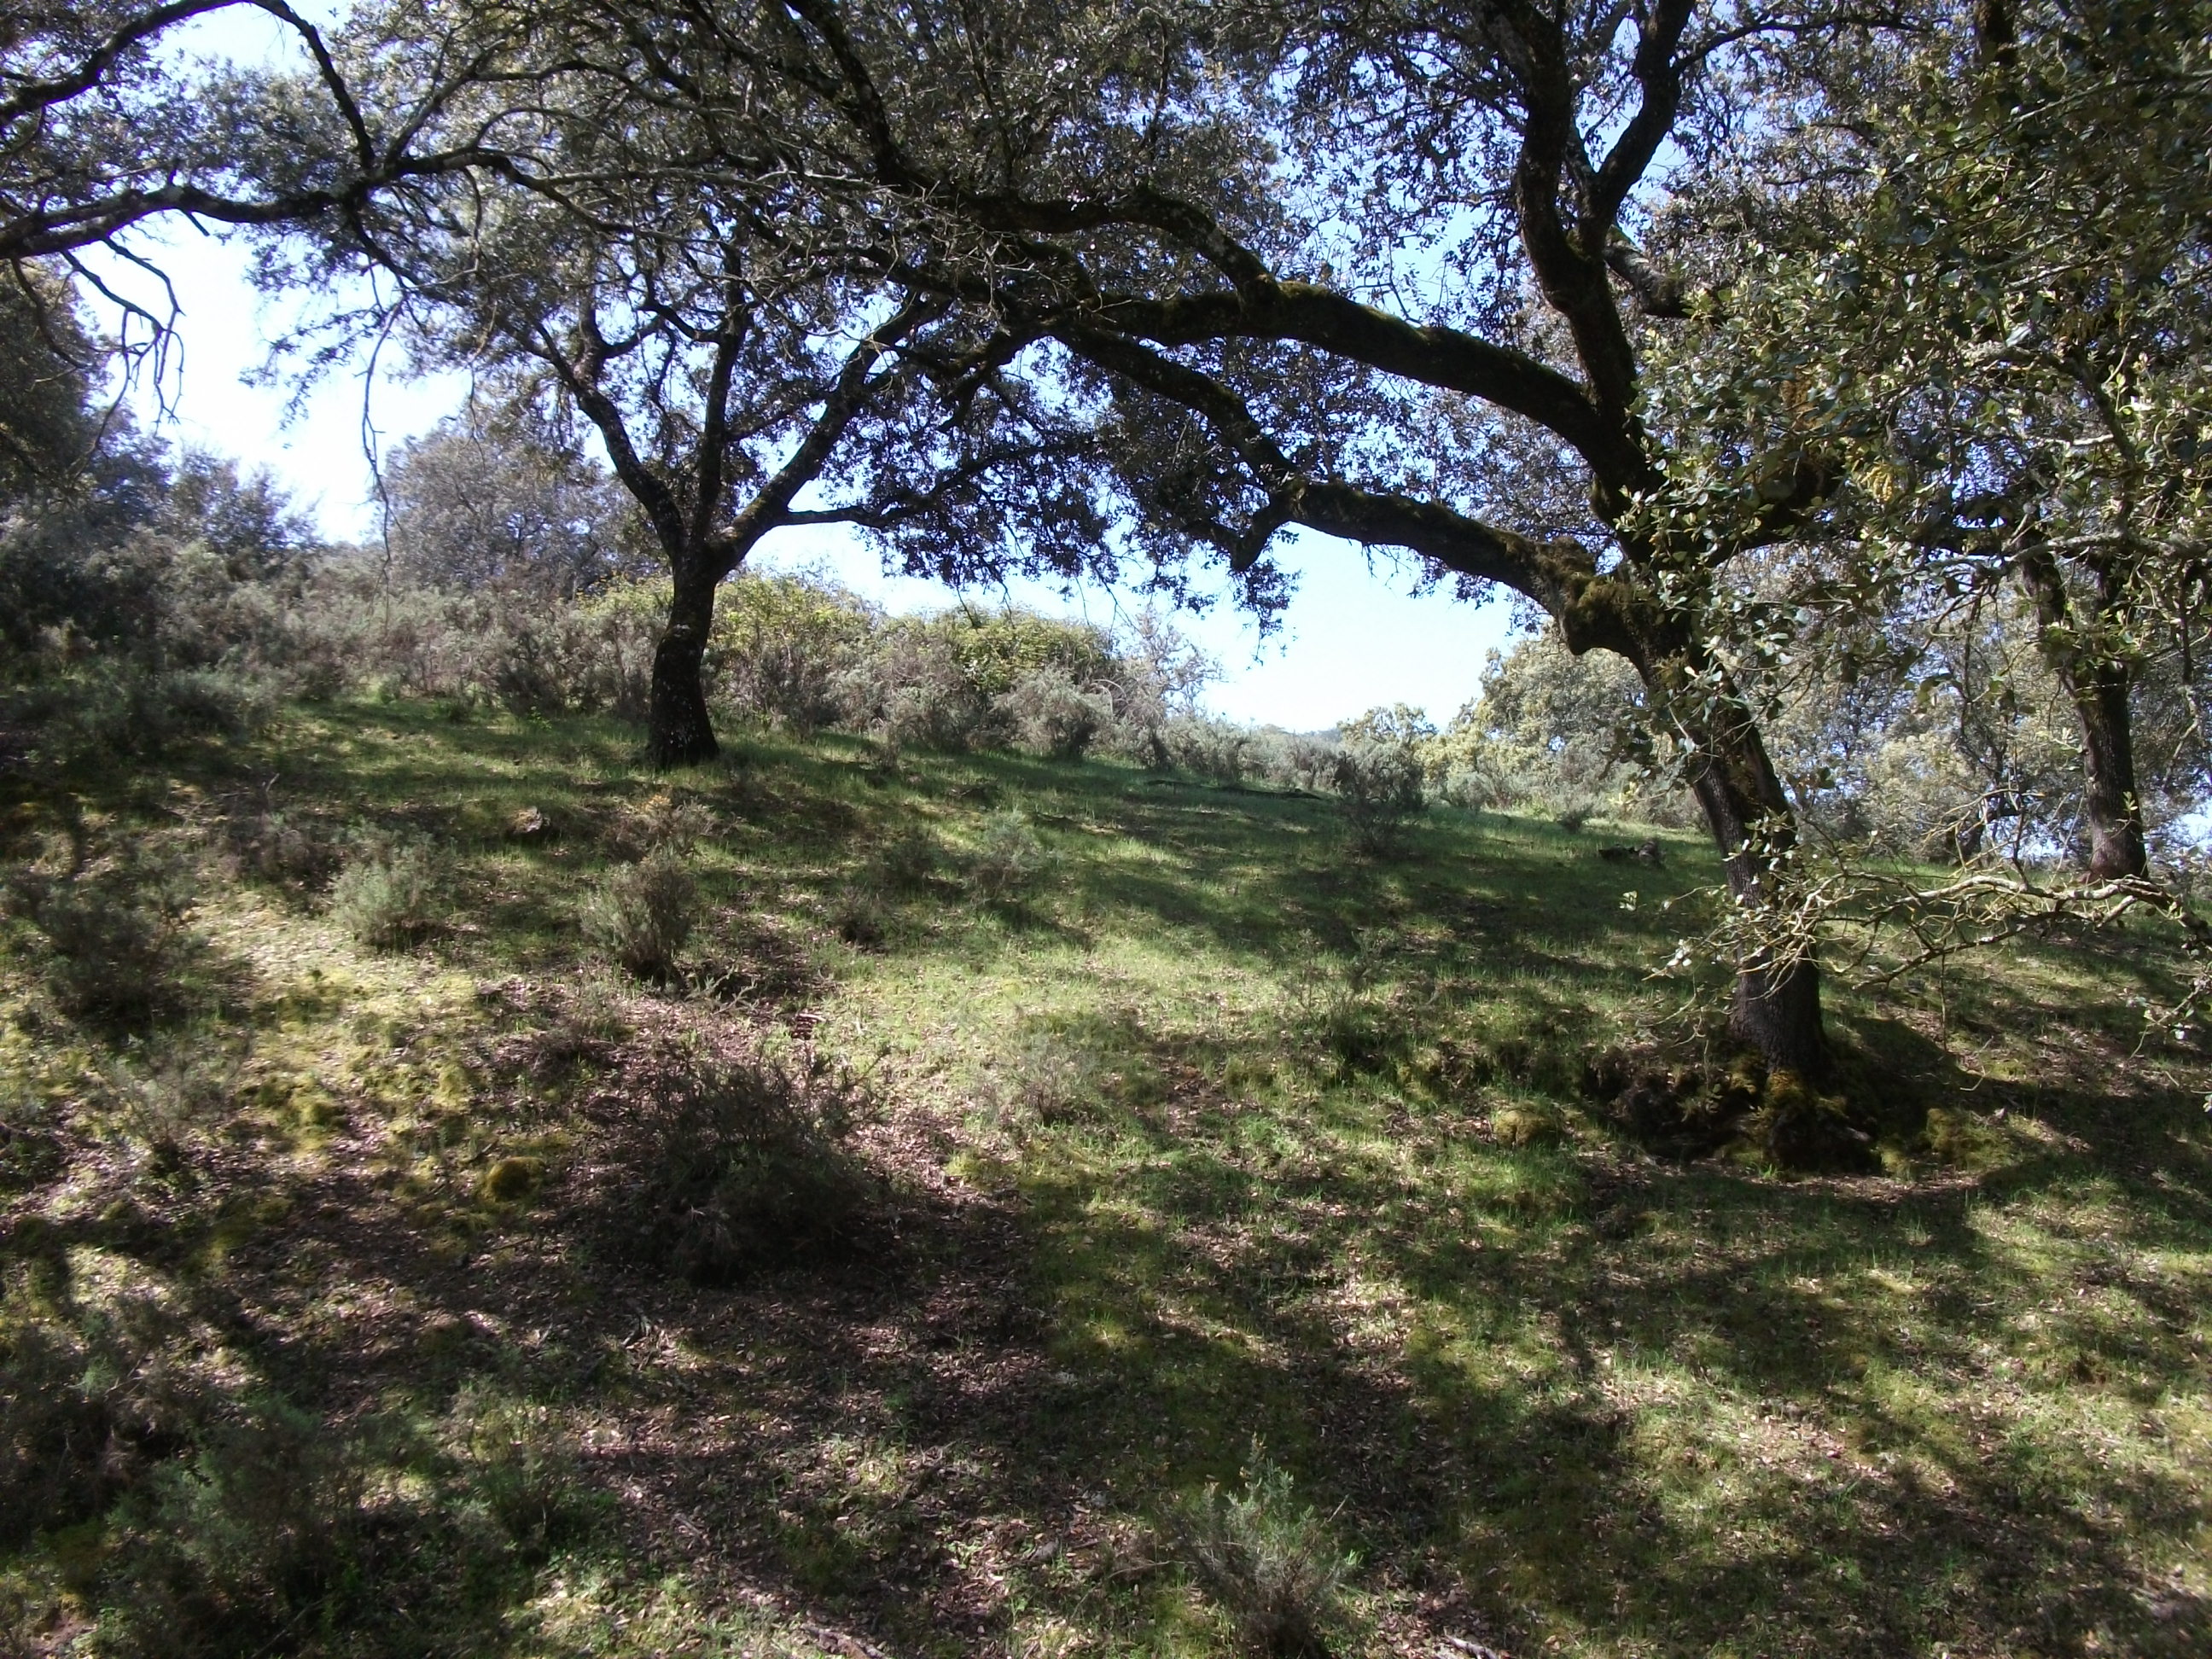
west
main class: Woodland
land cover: Broadleaved woodland
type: broadleaved evergreen forest
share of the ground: 50 - 75 %
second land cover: Shrubland without tree cover
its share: 50 - 75 %
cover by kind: broadleaved forest trees 60 %, shrubs 35 %, herbaceous plants 5 %
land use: Forestry
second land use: Agriculture (excluding fallow land and kitchen gardens)
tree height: > 5 m
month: April
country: ES
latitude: 37.9639
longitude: -6.7694
